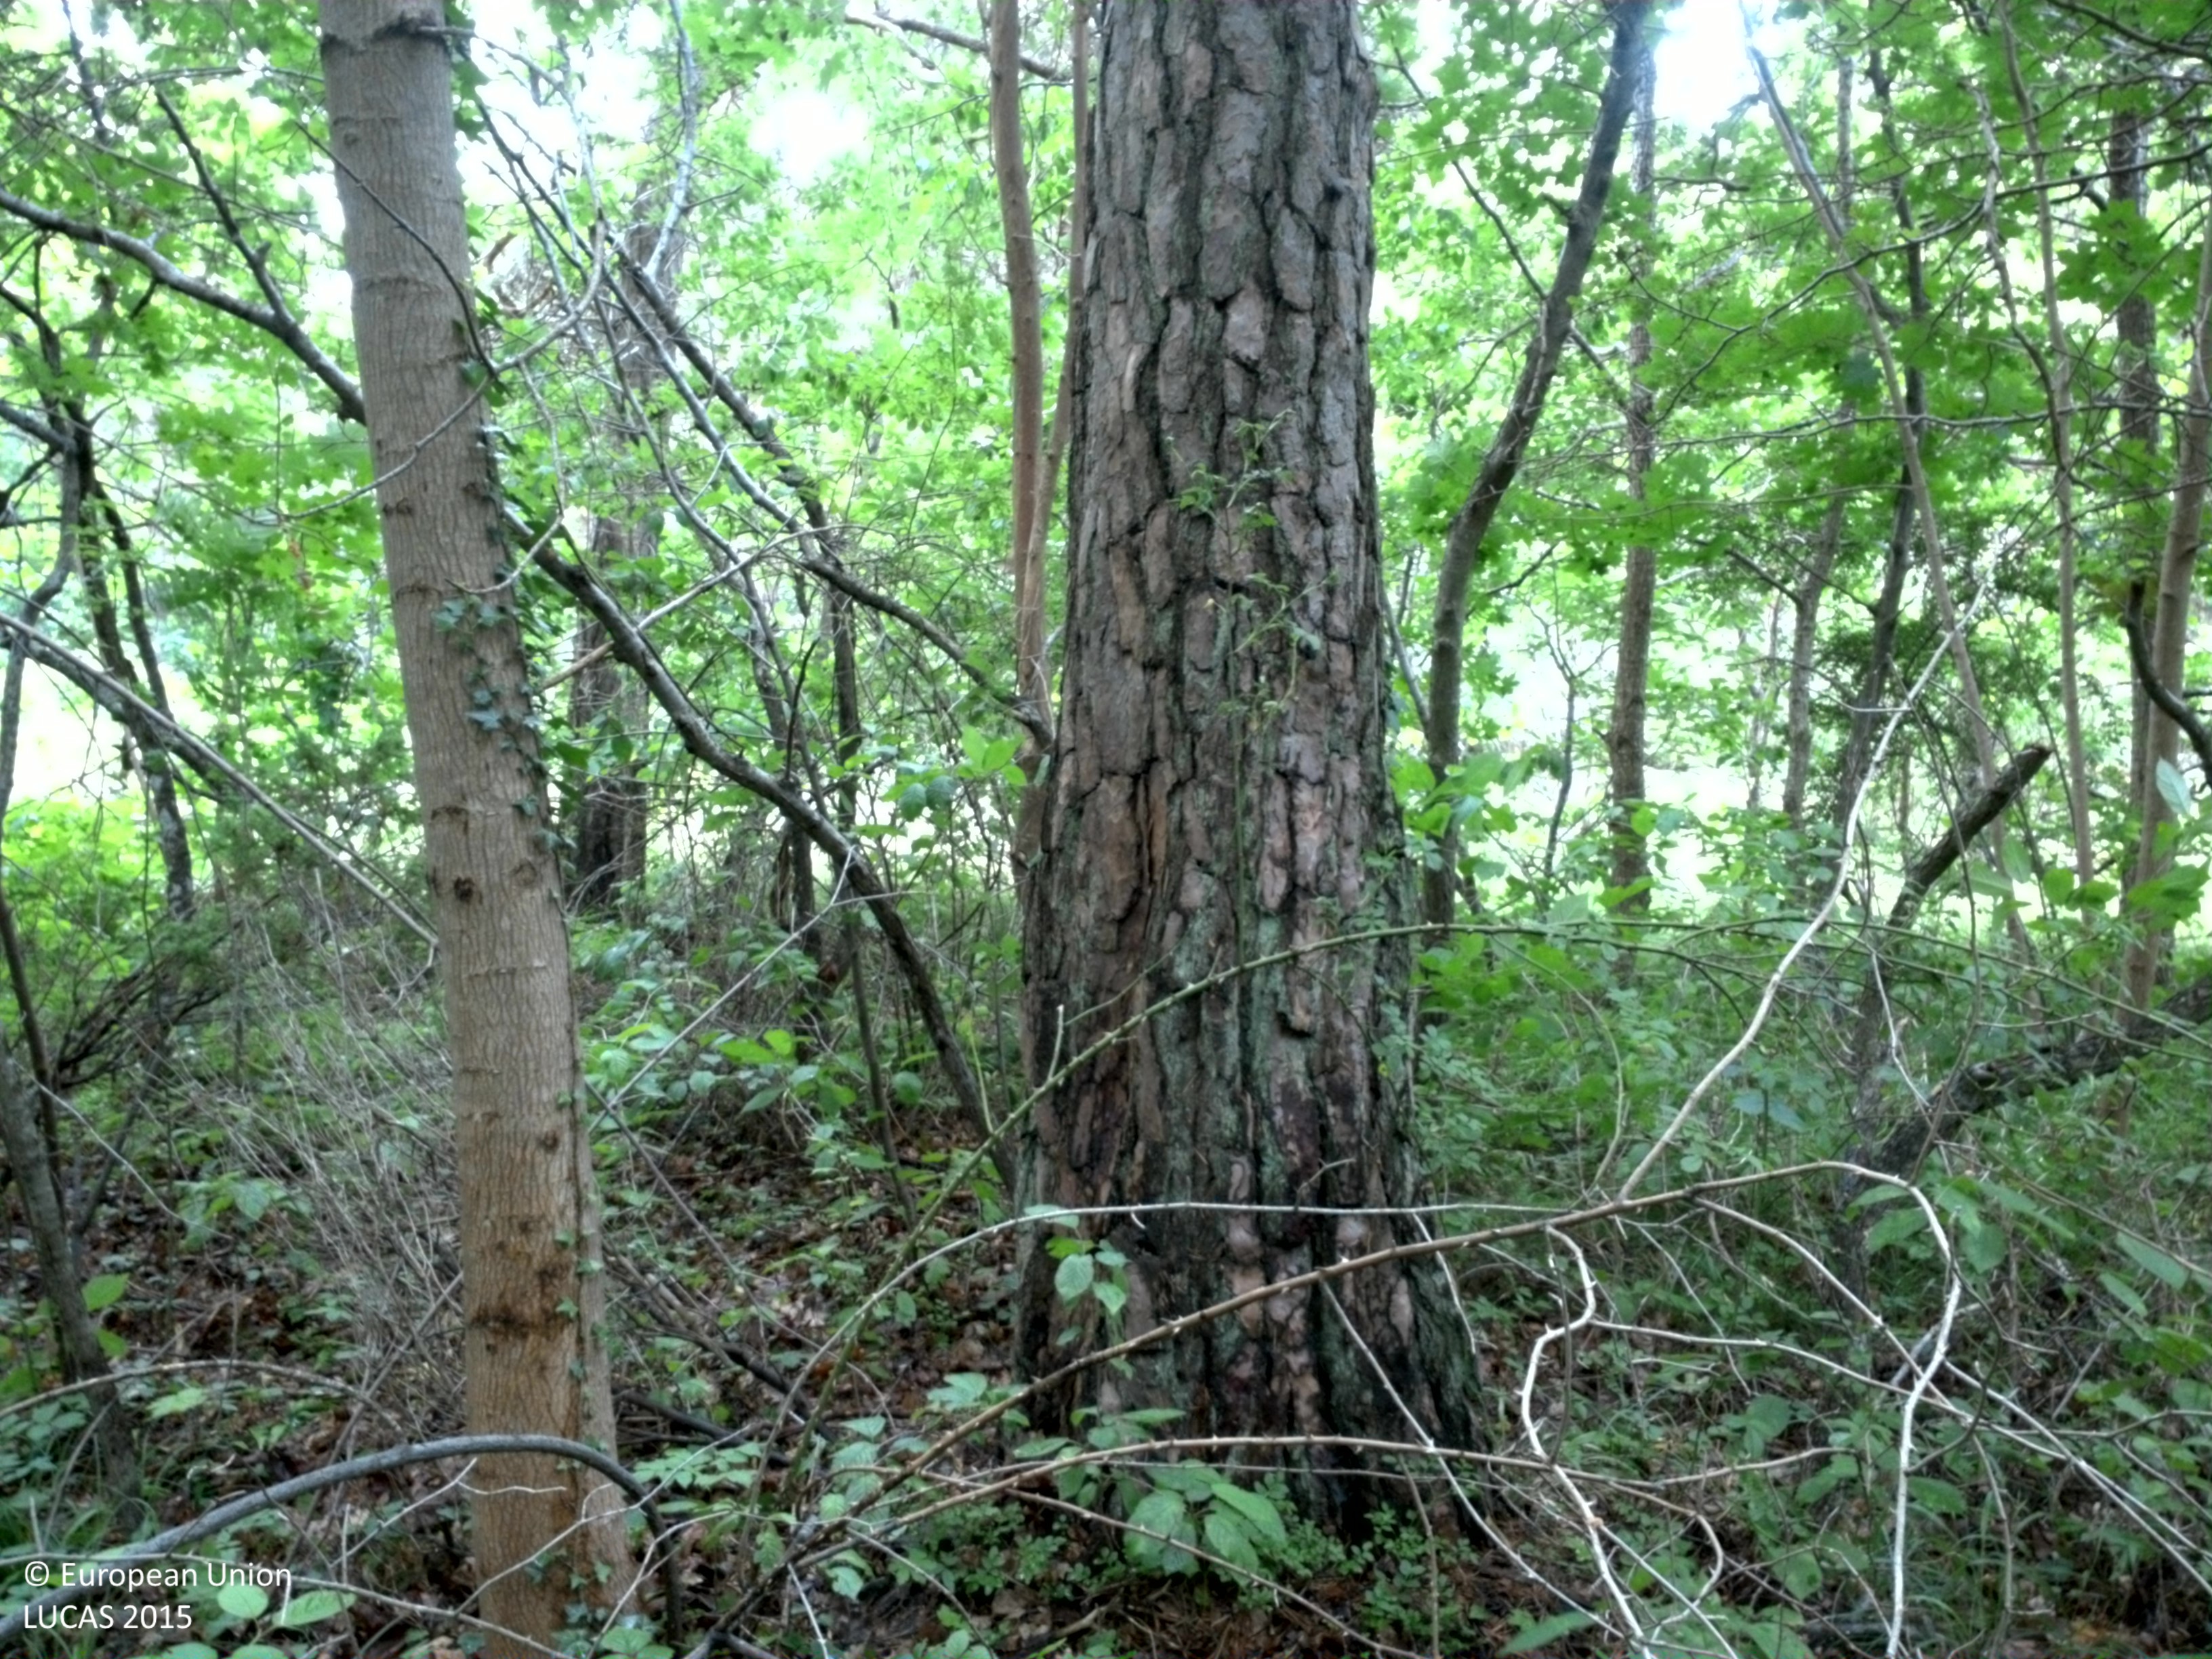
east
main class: Woodland
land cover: Pine dominated mixed woodland
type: hemiboreal forest and nemoral coniferous forest and mixed broadleaved-coniferous forest
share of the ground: > 75 %
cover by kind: coniferous forest trees 45 %, broadleaved forest trees 35 %, herbaceous plants 15 %, shrubs 5 %
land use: Forestry
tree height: > 5 m
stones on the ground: < 10 %
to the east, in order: Pine dominated mixed woodland; Tracks; Pine dominated mixed woodland; Tracks; Pine dominated mixed woodland
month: July
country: SE
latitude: 57.6035
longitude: 18.2569
